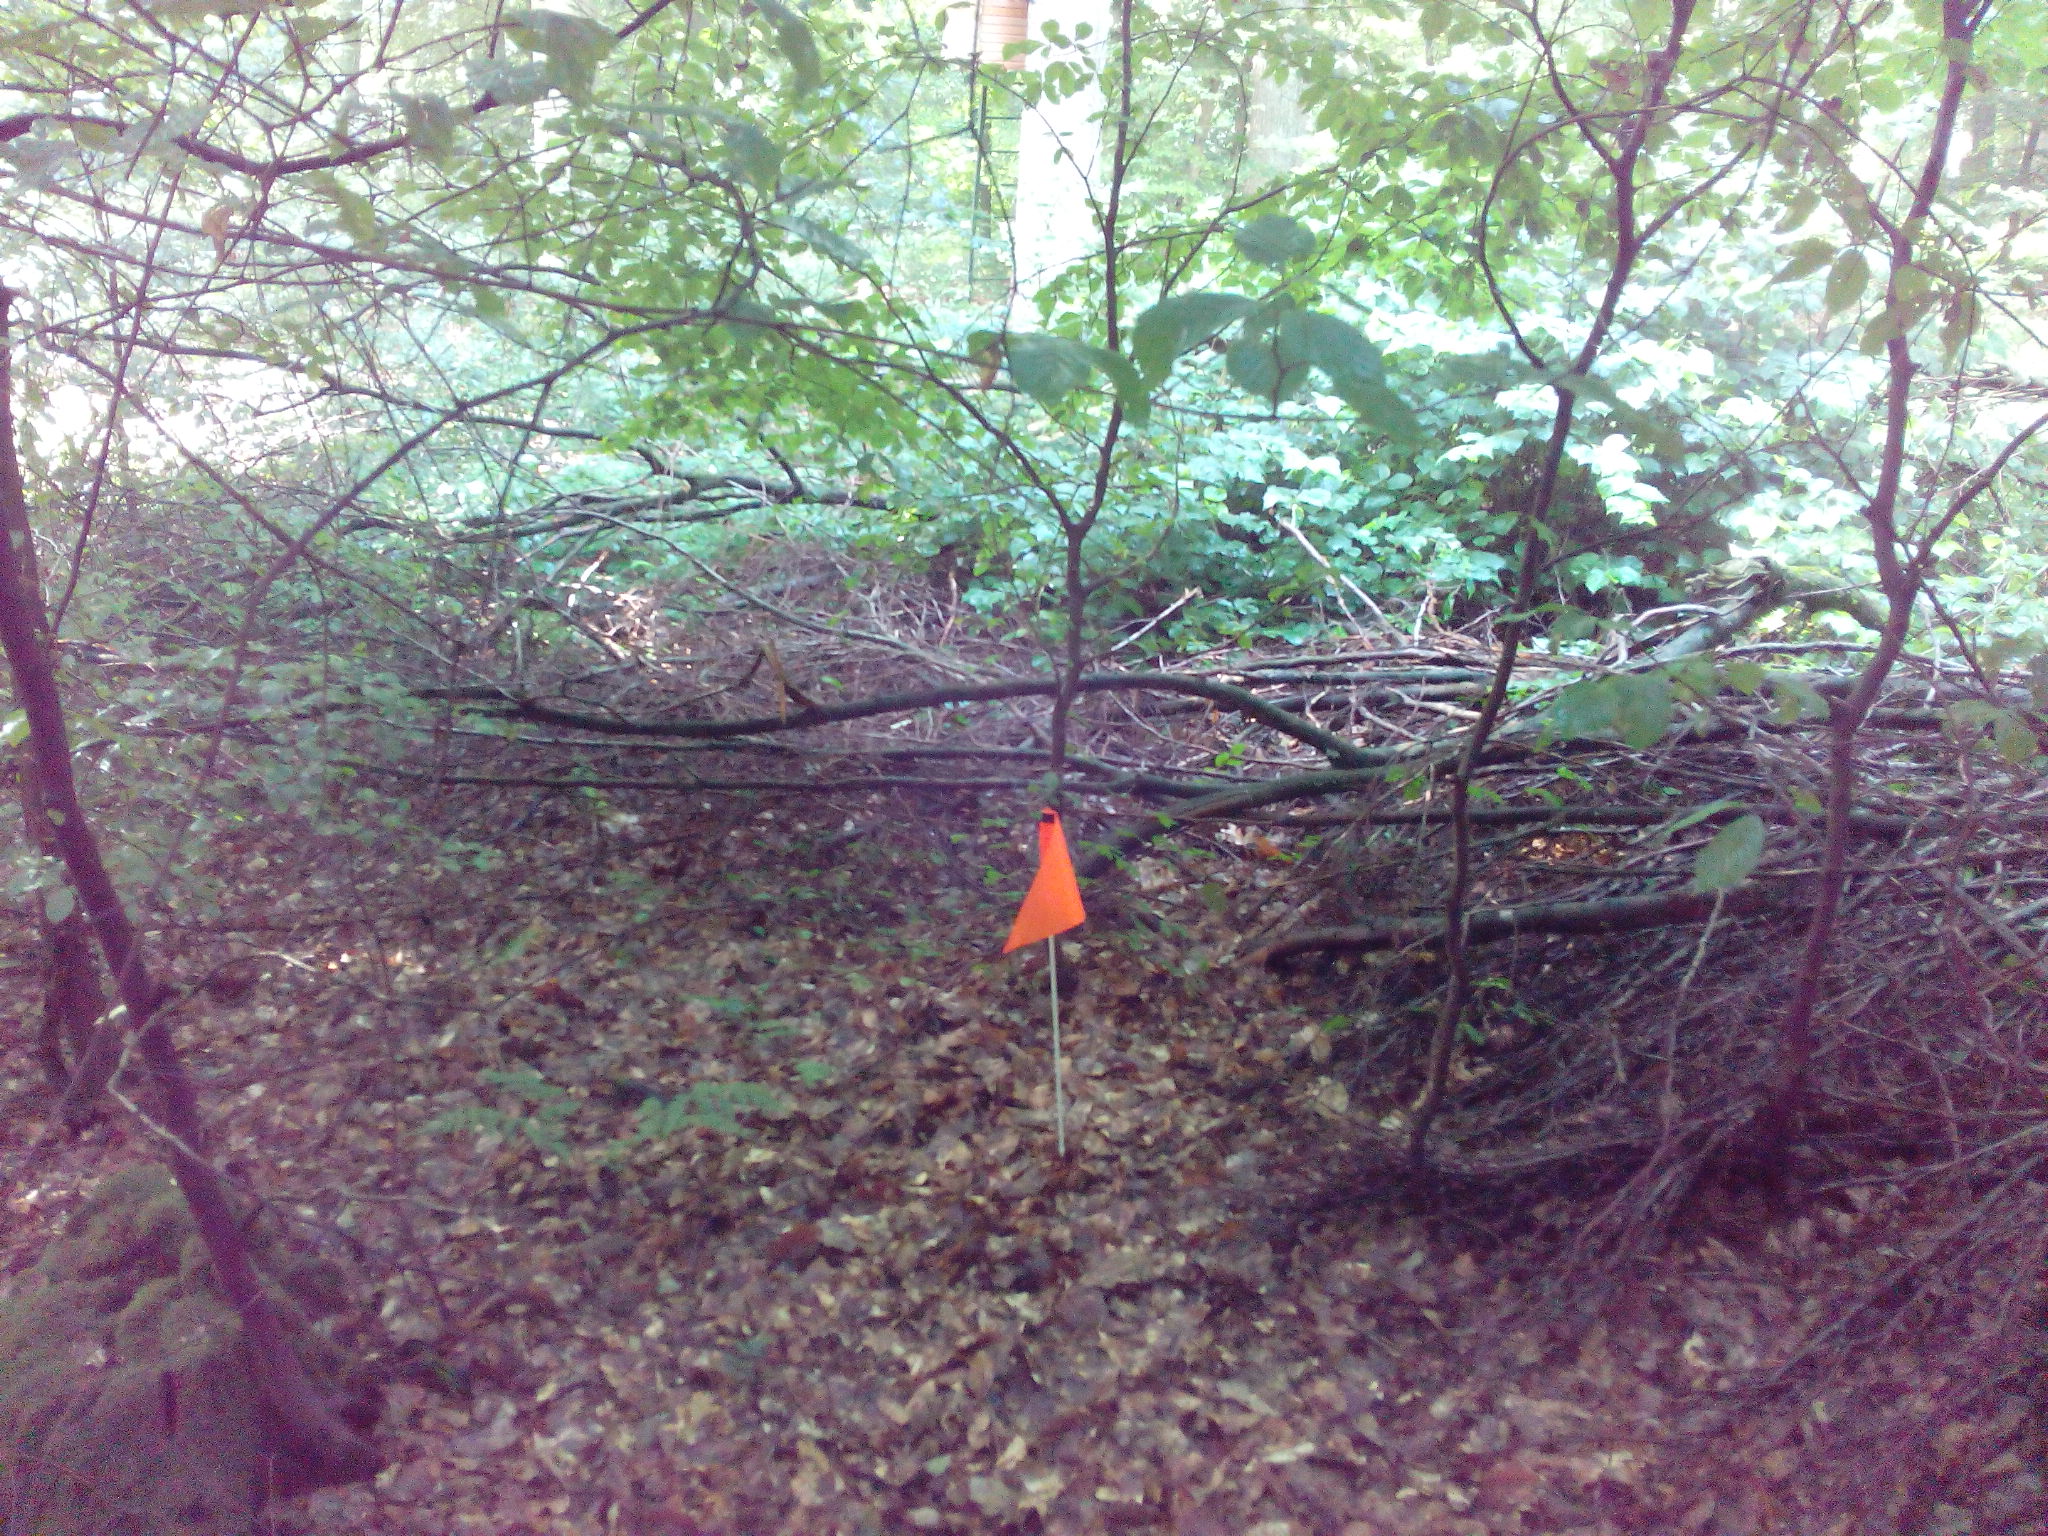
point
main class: Woodland
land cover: Broadleaved woodland
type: mesophytic deciduous forest
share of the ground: > 75 %
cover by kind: broadleaved forest trees 90 %, herbaceous plants 10 %
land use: Forestry
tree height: > 5 m
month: August
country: DE
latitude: 52.1078
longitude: 9.8978
